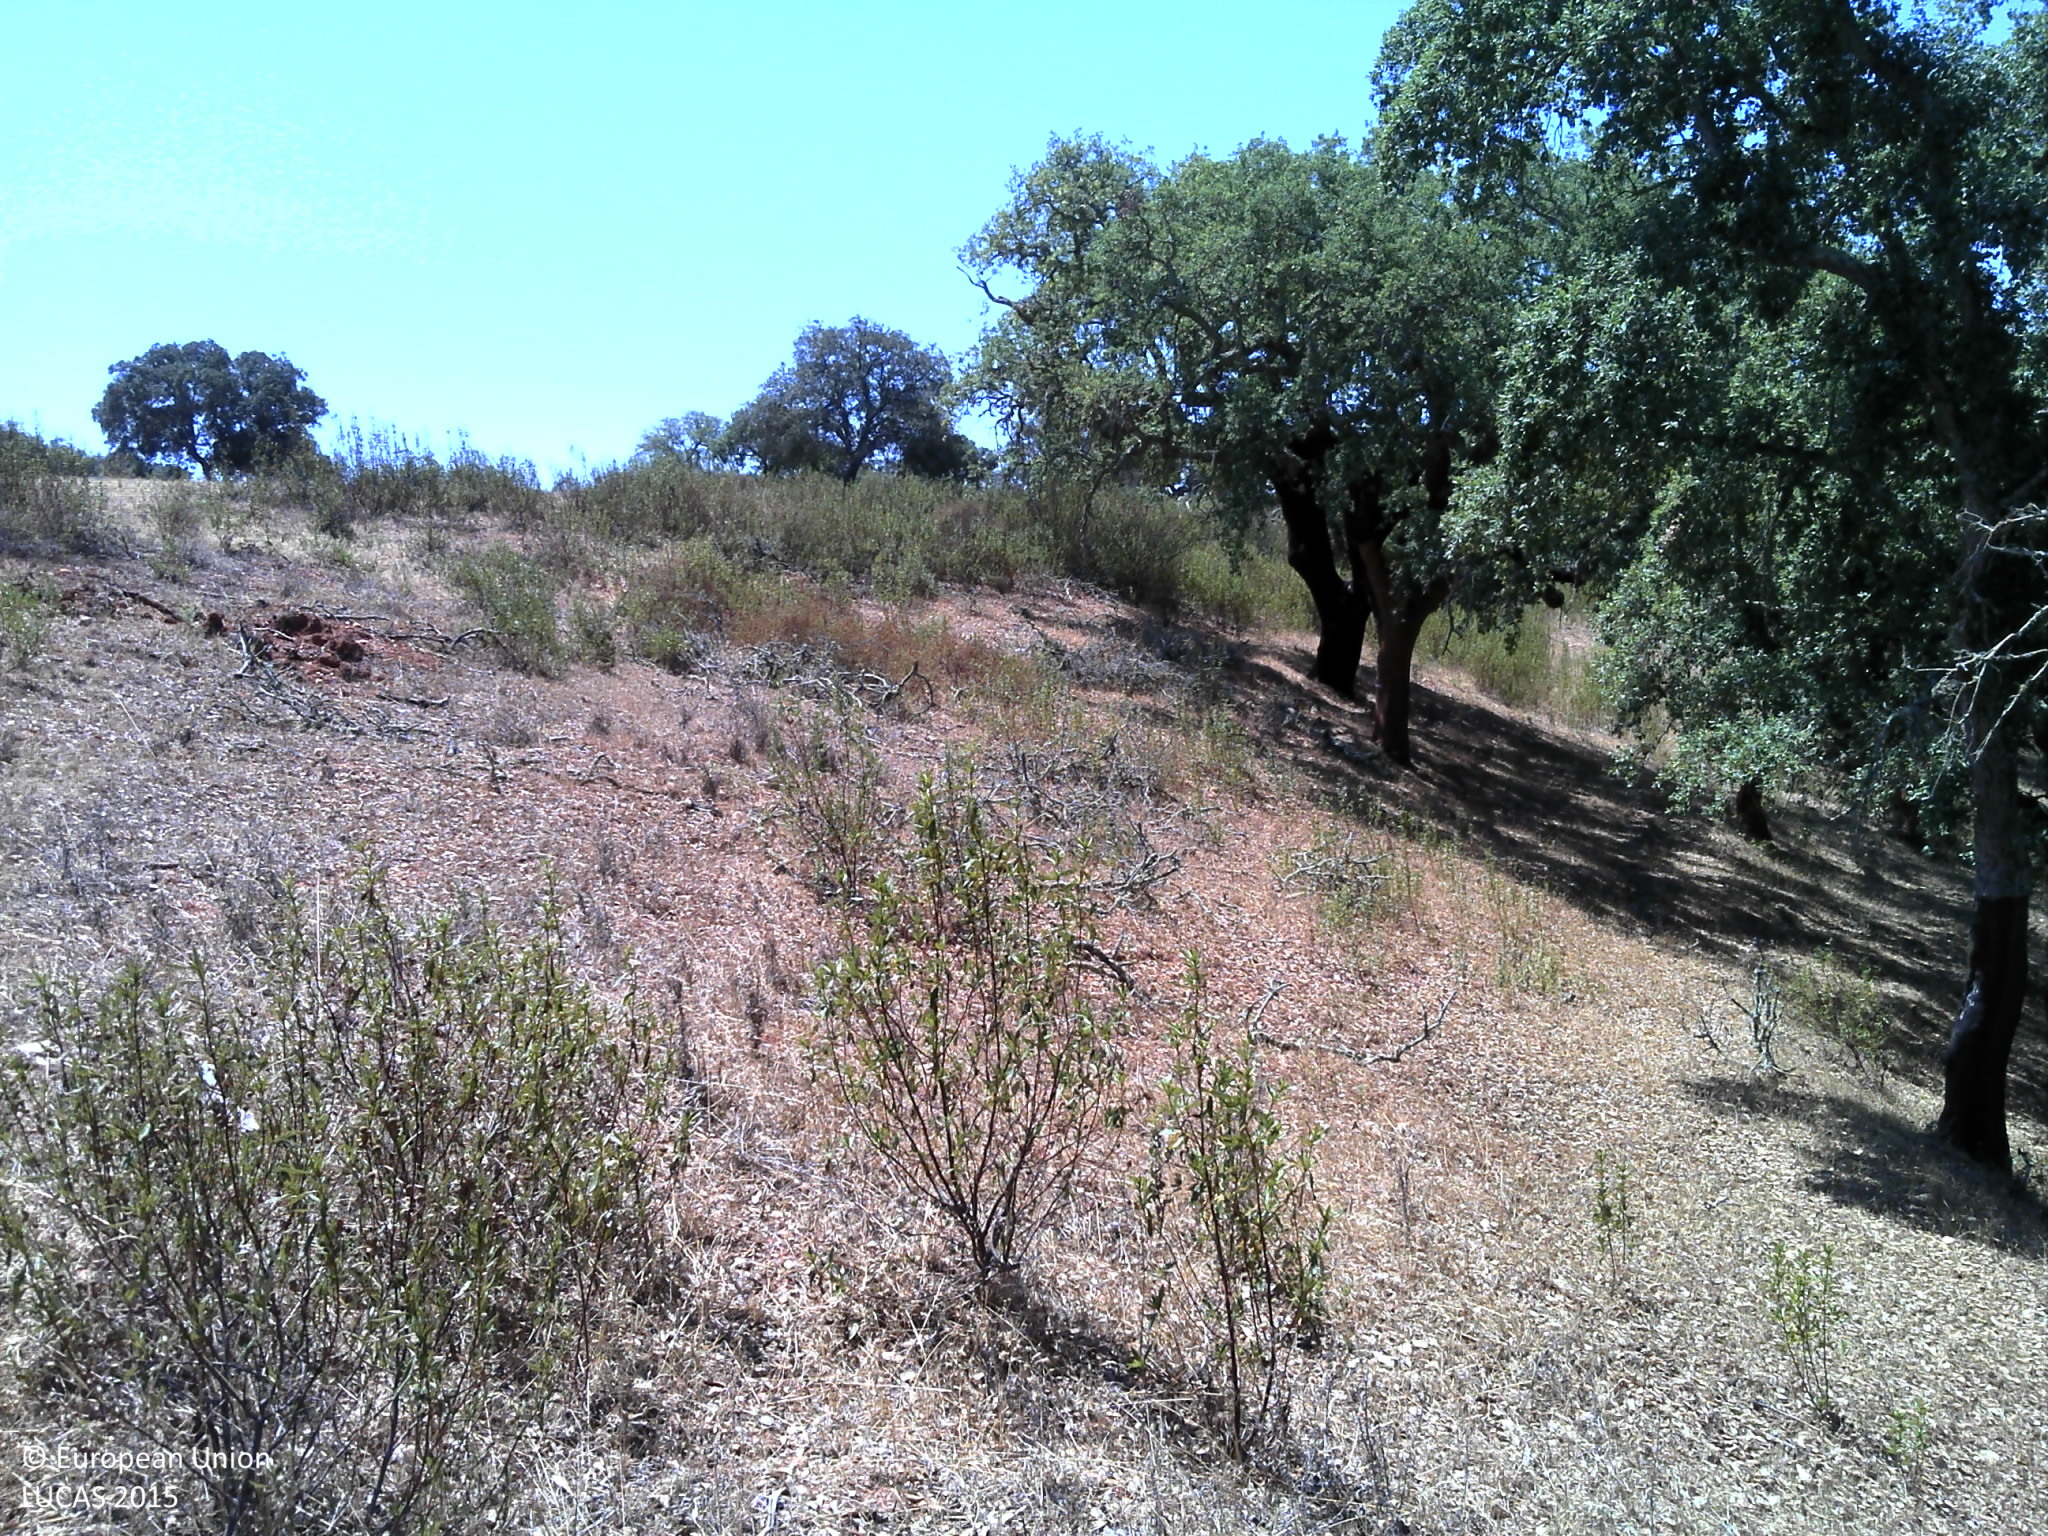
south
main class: Woodland
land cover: Broadleaved woodland
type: broadleaved evergreen forest
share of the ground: 10 - 25 %
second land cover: Grassland without tree/shrub cover
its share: 25 - 50 %
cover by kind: herbaceous plants 50 %, consolidated bare surface 30 %, broadleaved forest trees 20 %
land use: Forestry
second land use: Agriculture (excluding fallow land and kitchen gardens)
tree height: > 5 m
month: July
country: PT
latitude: 37.7313
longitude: -8.3121
